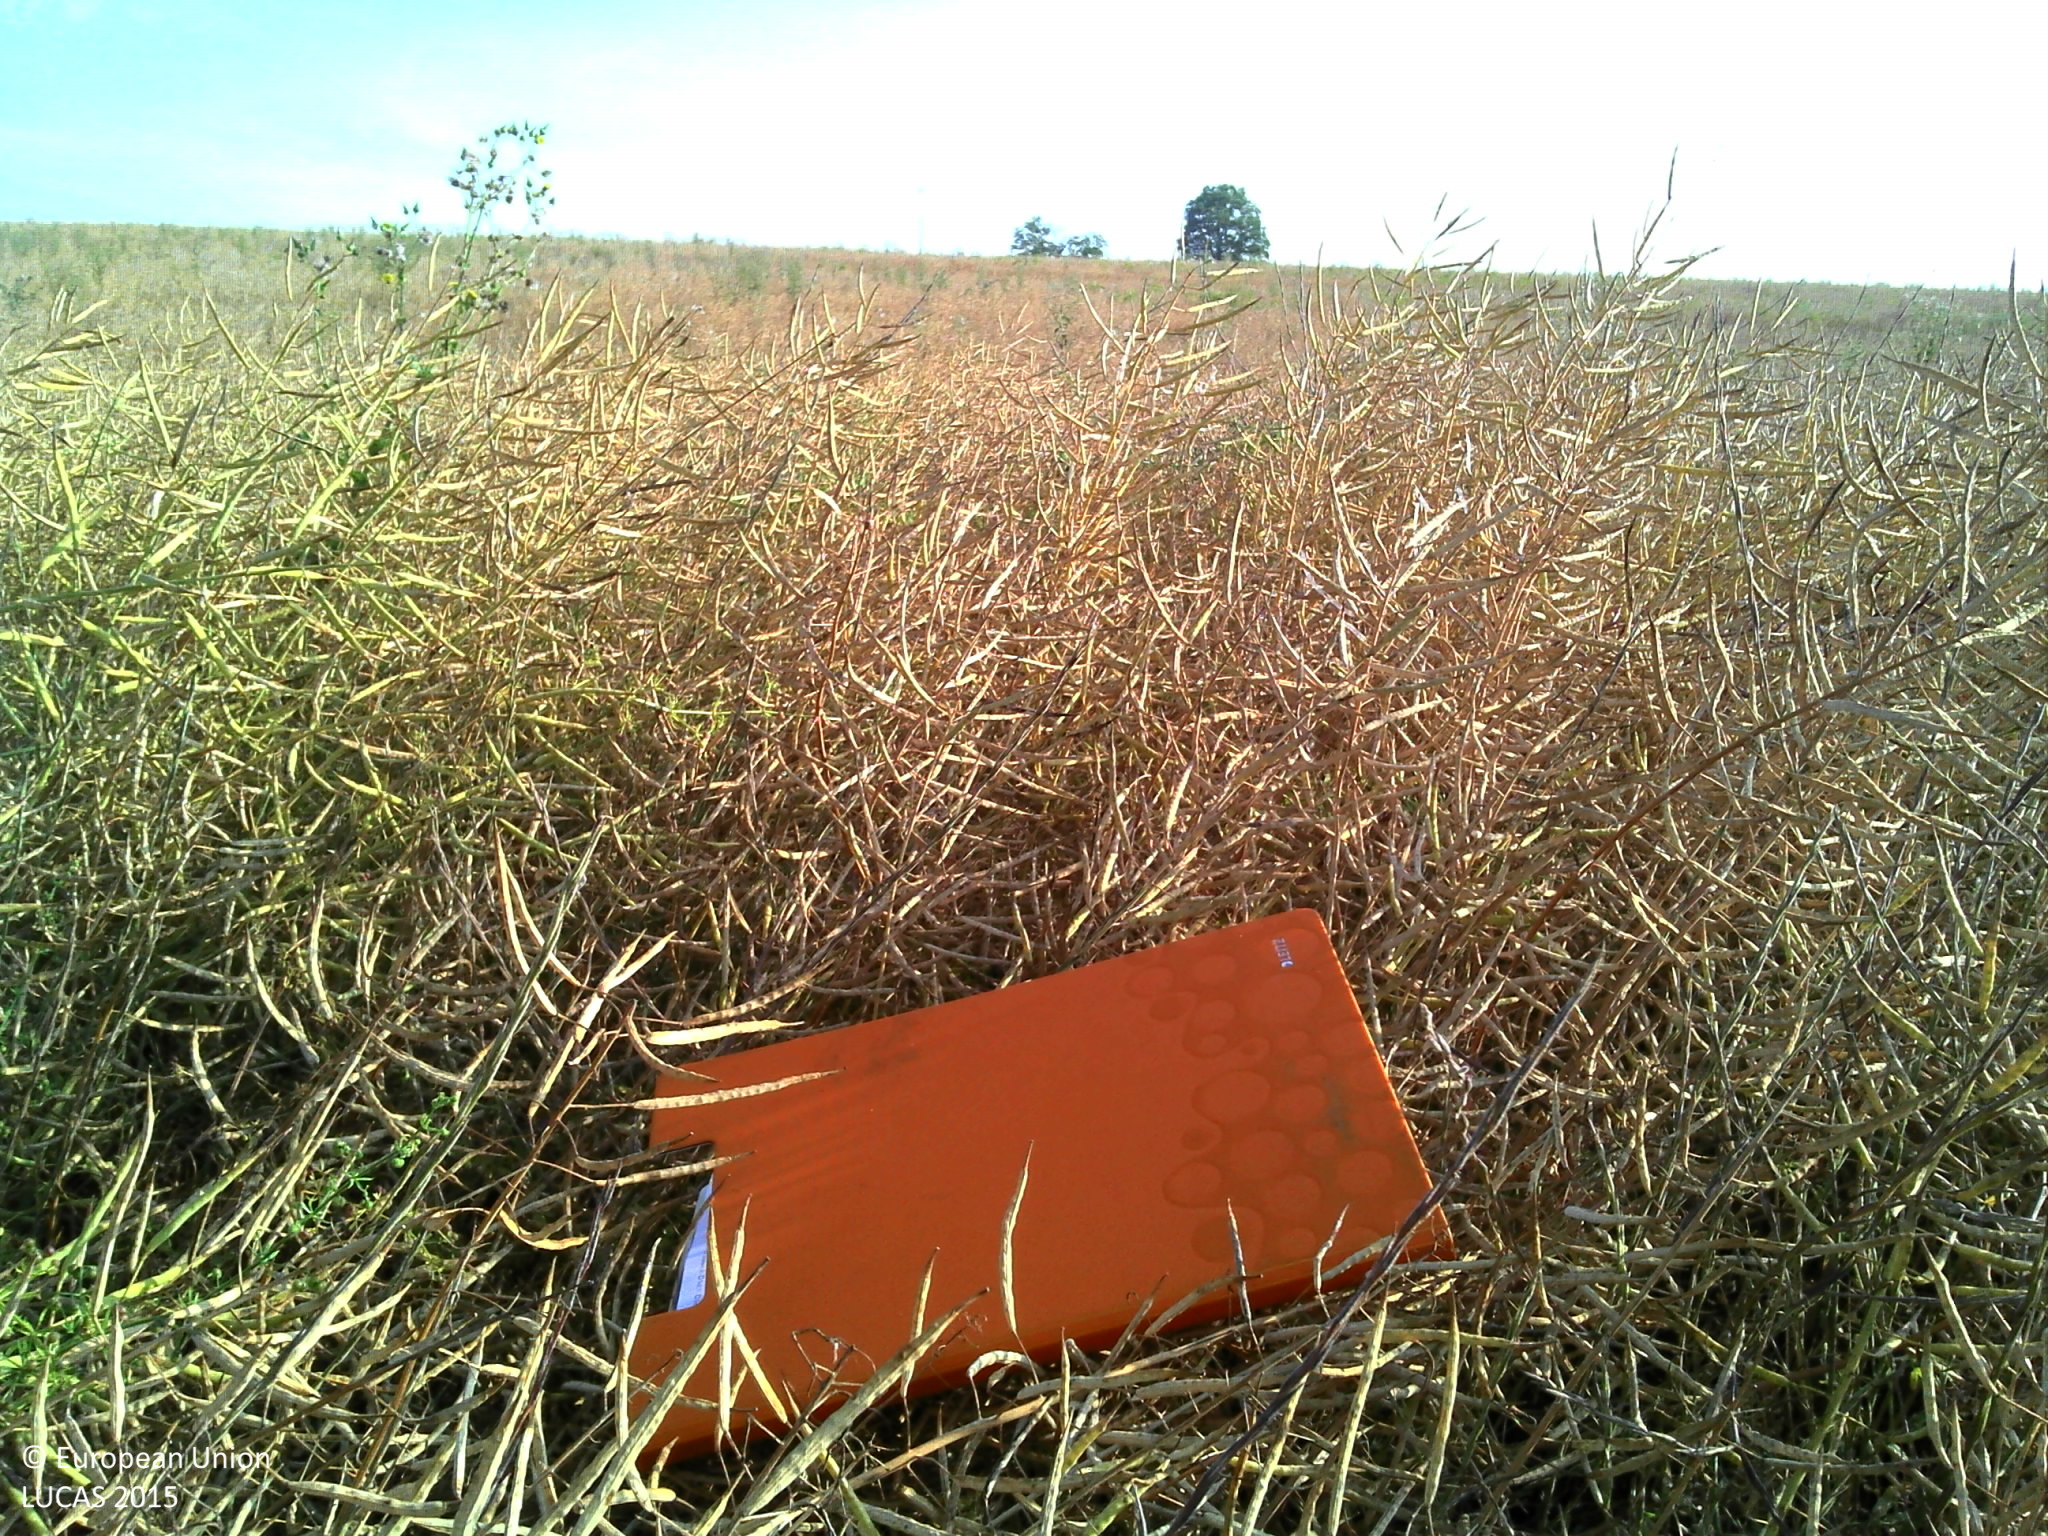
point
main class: Cropland
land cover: Rape and turnip rape
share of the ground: > 75 %
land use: Agriculture (excluding fallow land and kitchen gardens)
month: July
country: FR
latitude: 47.0633
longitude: 3.6119
